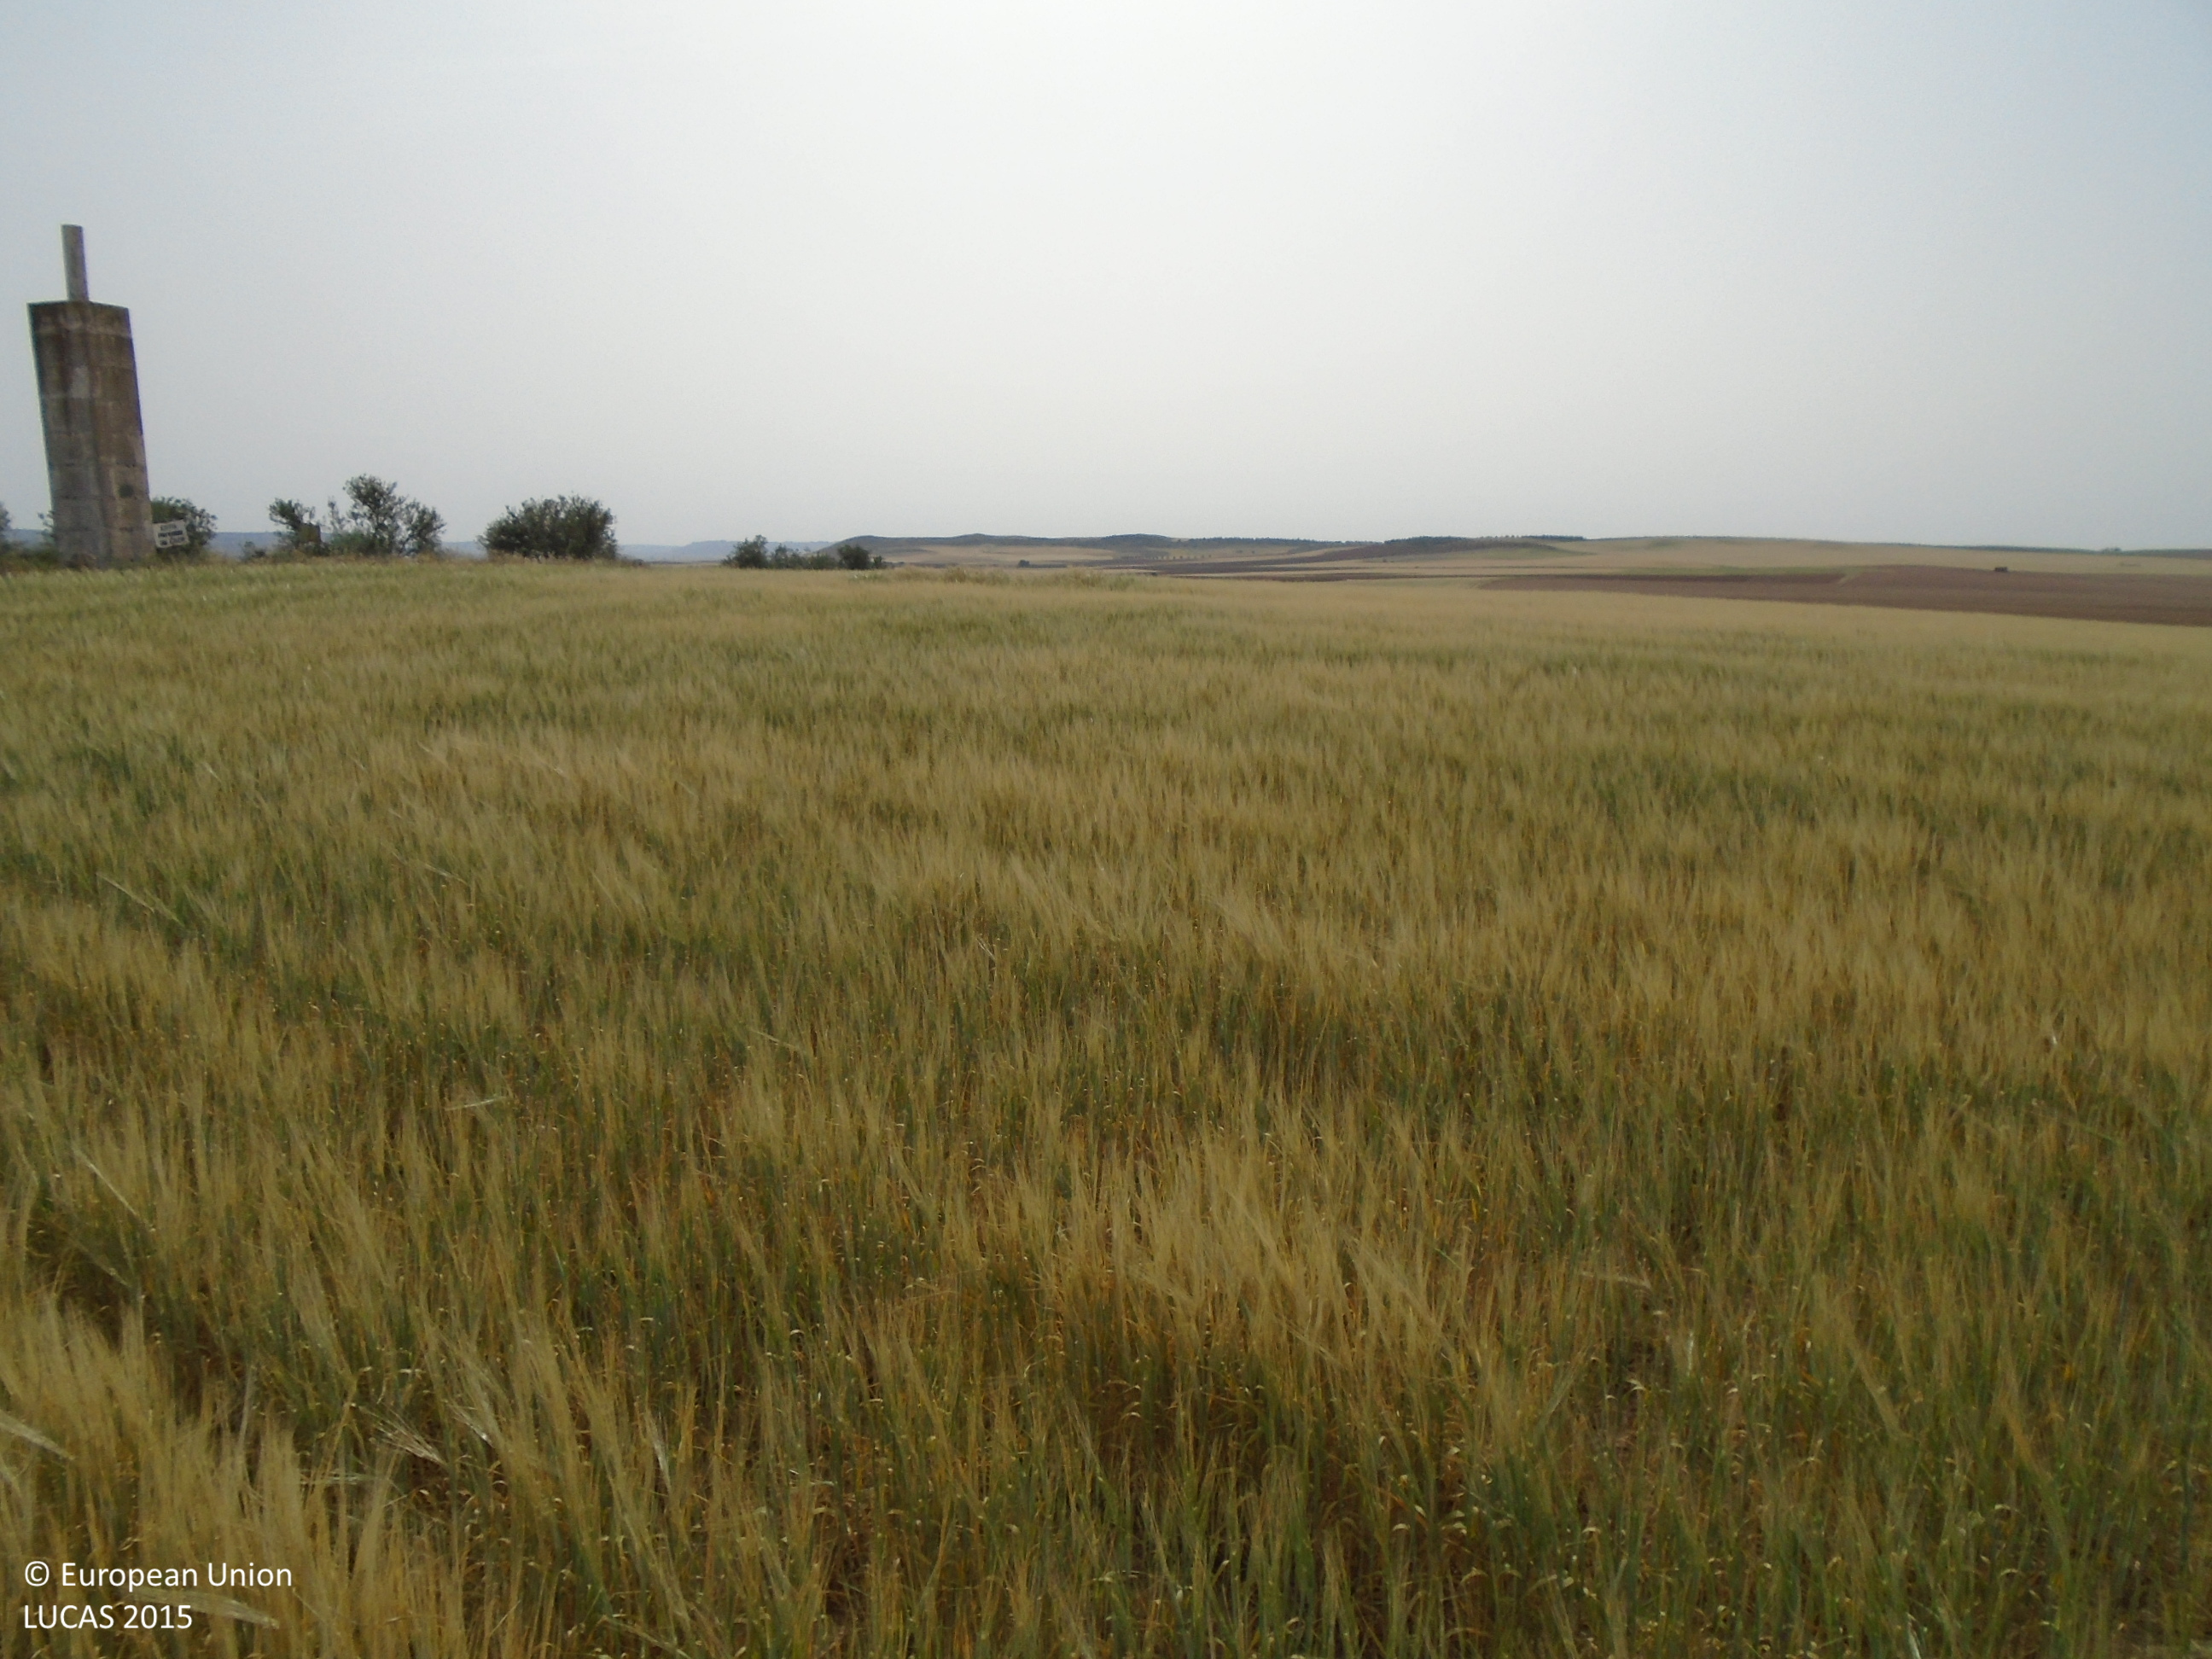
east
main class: Cropland
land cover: Barley
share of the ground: > 75 %
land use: Agriculture (excluding fallow land and kitchen gardens)
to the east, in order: Barley
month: May
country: ES
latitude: 39.7905
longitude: -3.6091
